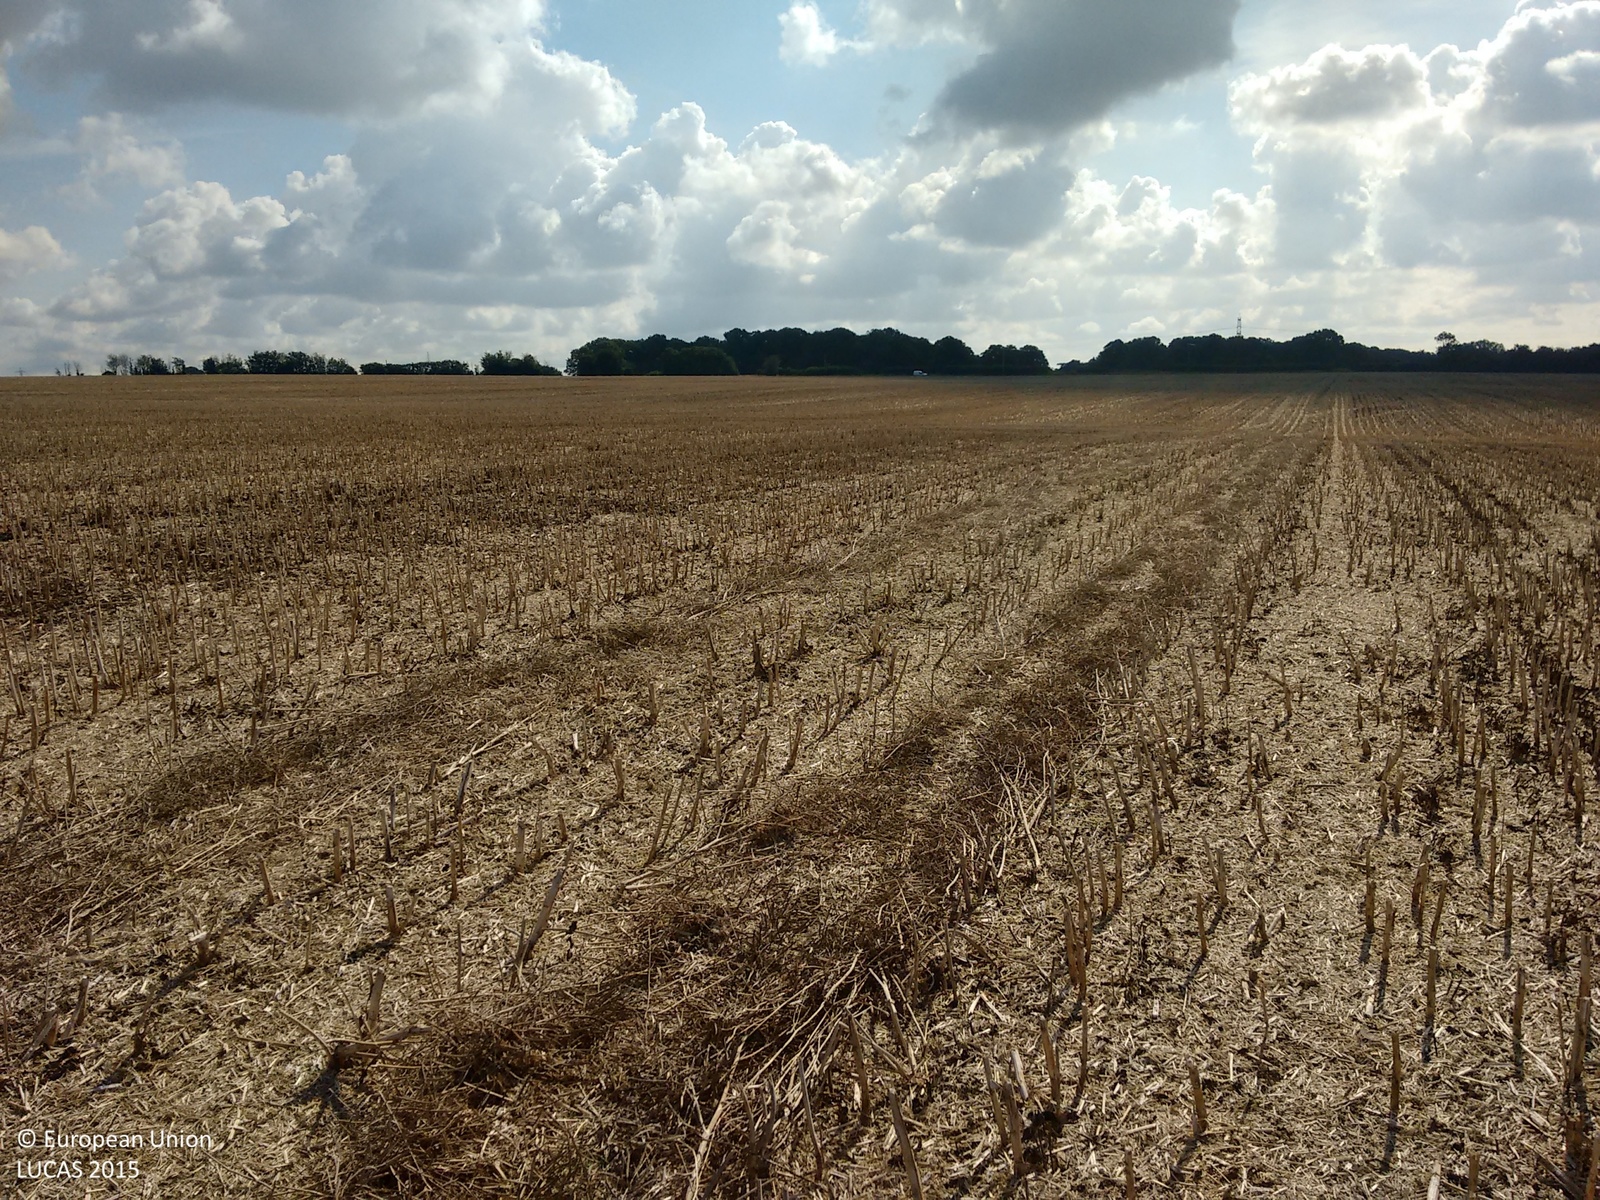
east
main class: Cropland
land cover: Rape and turnip rape
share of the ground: 25 - 50 %
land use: Agriculture (excluding fallow land and kitchen gardens)
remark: Harvested field
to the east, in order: Rape and turnip rape
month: July
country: GB
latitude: 51.8797
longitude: 0.6327
